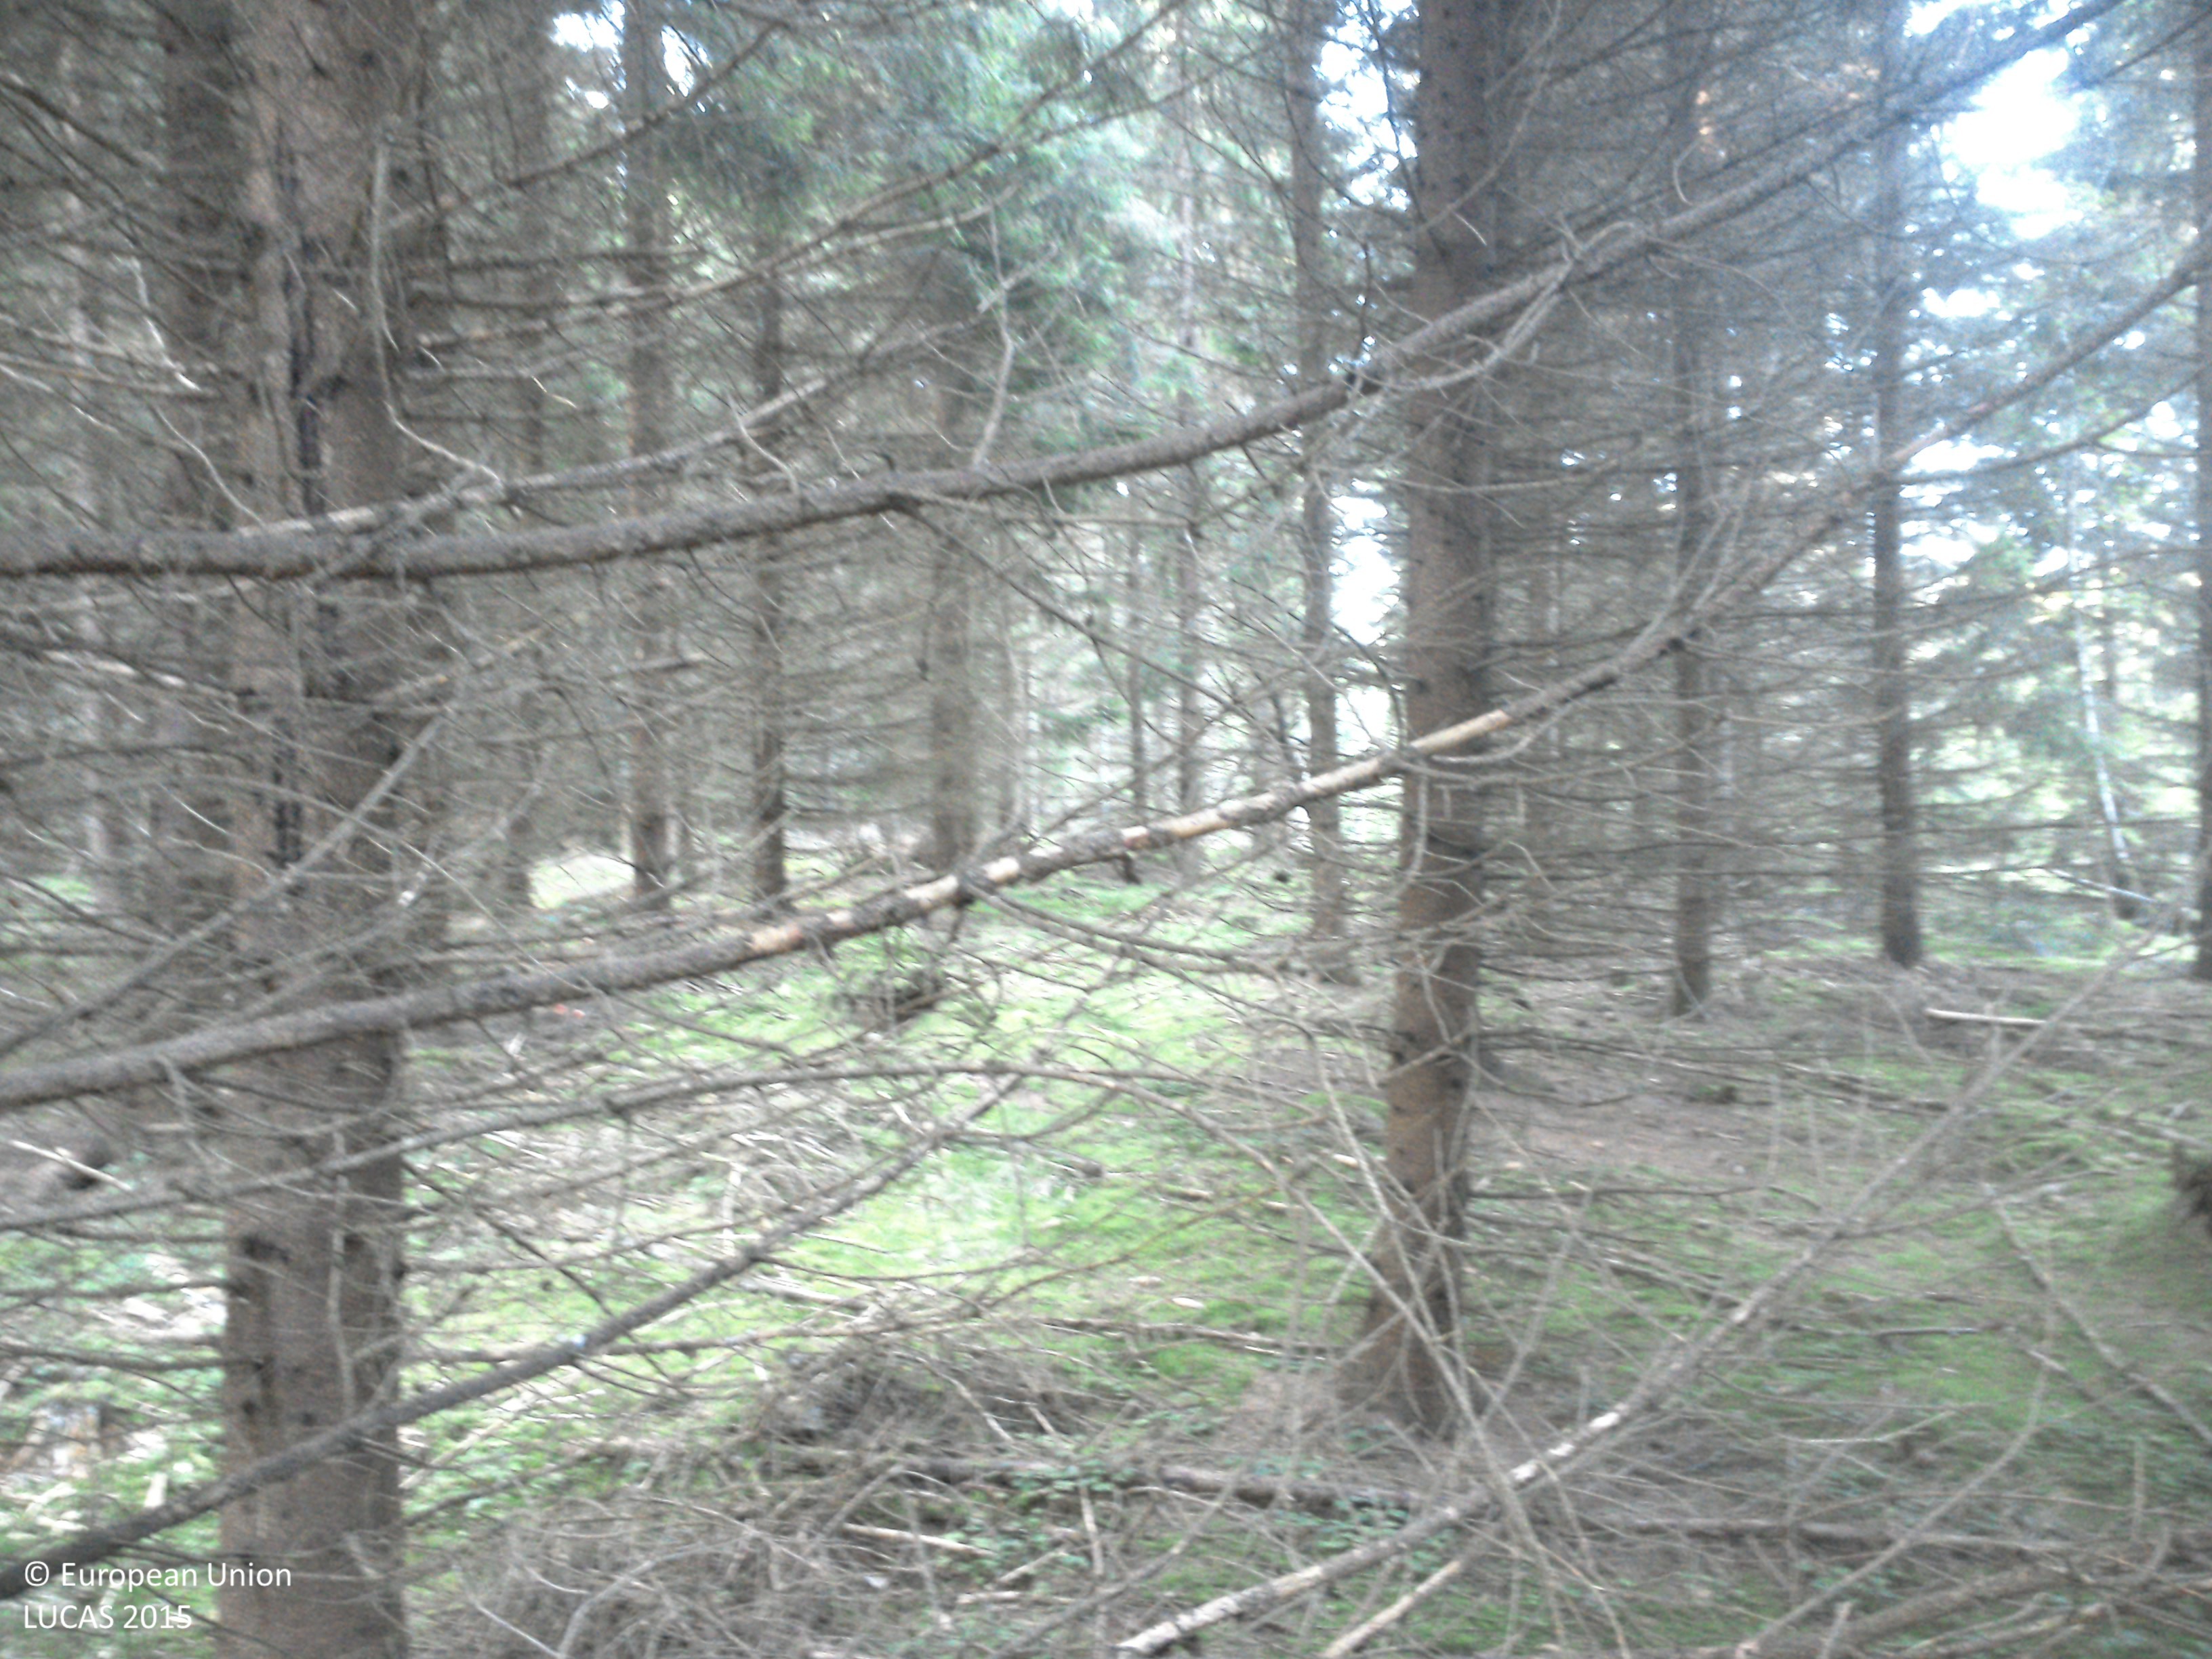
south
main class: Woodland
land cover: Spruce dominated coniferous woodland
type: boreal forest
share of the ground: > 75 %
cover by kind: coniferous forest trees 90 %, lichens and mosses 5 %, unconsolidated bare surface 5 %
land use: Forestry
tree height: > 5 m
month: August
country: SE
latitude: 57.9727
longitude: 15.2531
